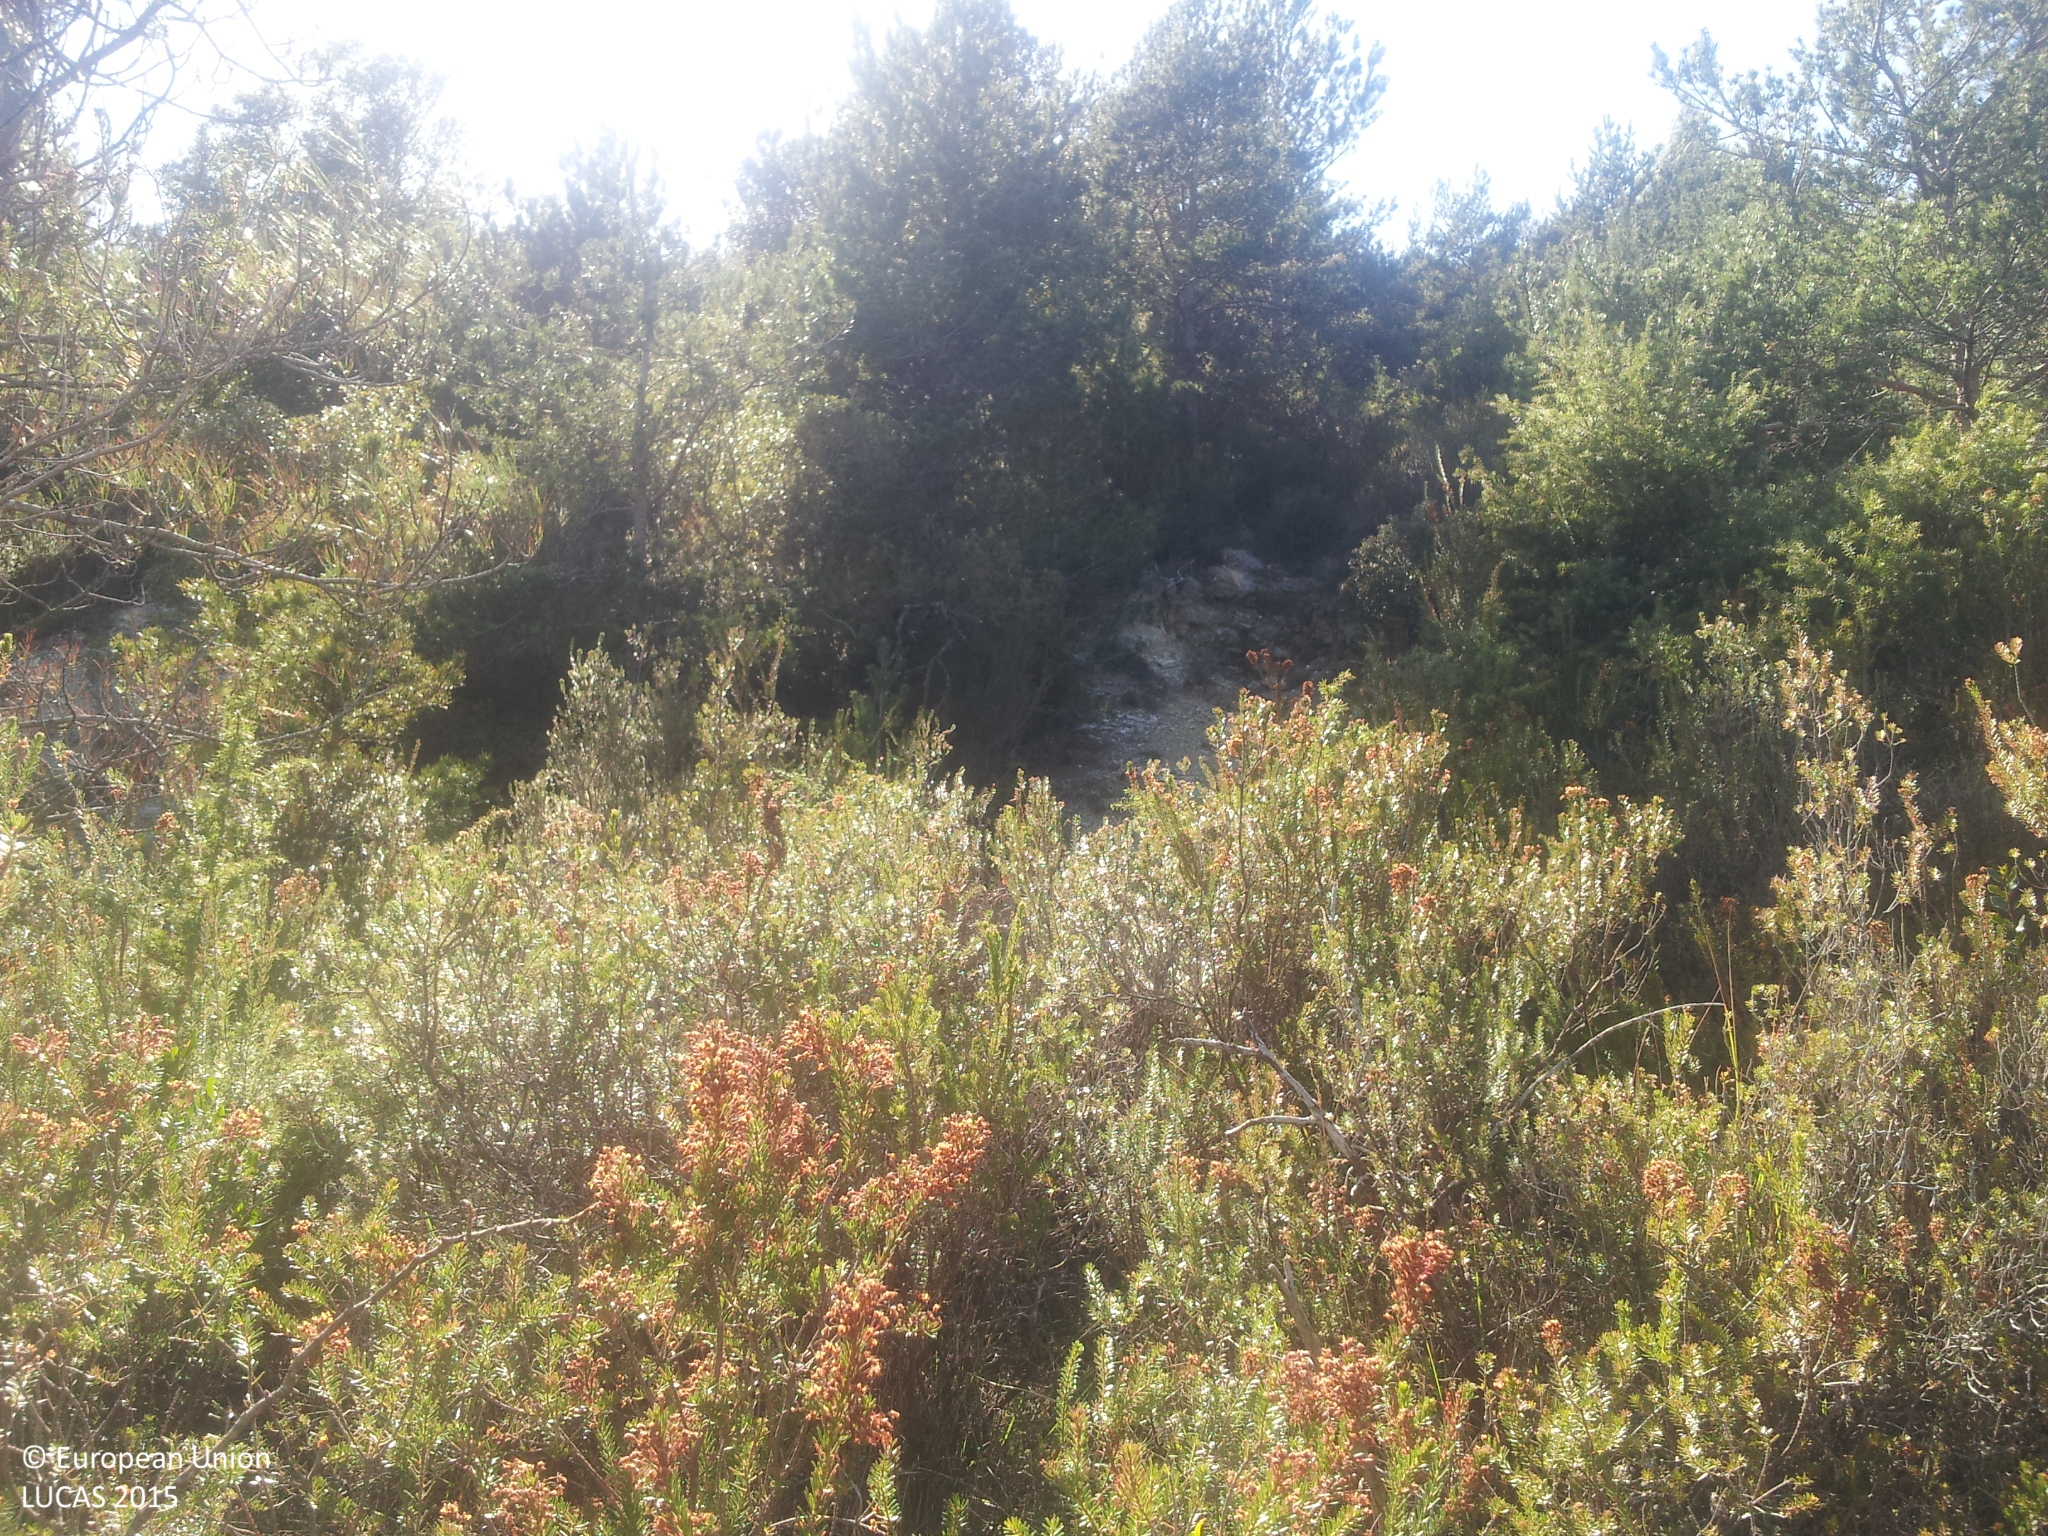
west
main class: Woodland
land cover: Pine dominated coniferous woodland
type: coniferous forest of the mediterranean region
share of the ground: 50 - 75 %
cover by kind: coniferous forest trees 70 %, shrubs 30 %
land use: Forestry
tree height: > 5 m
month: April
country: ES
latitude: 42.2514
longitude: 2.5352
